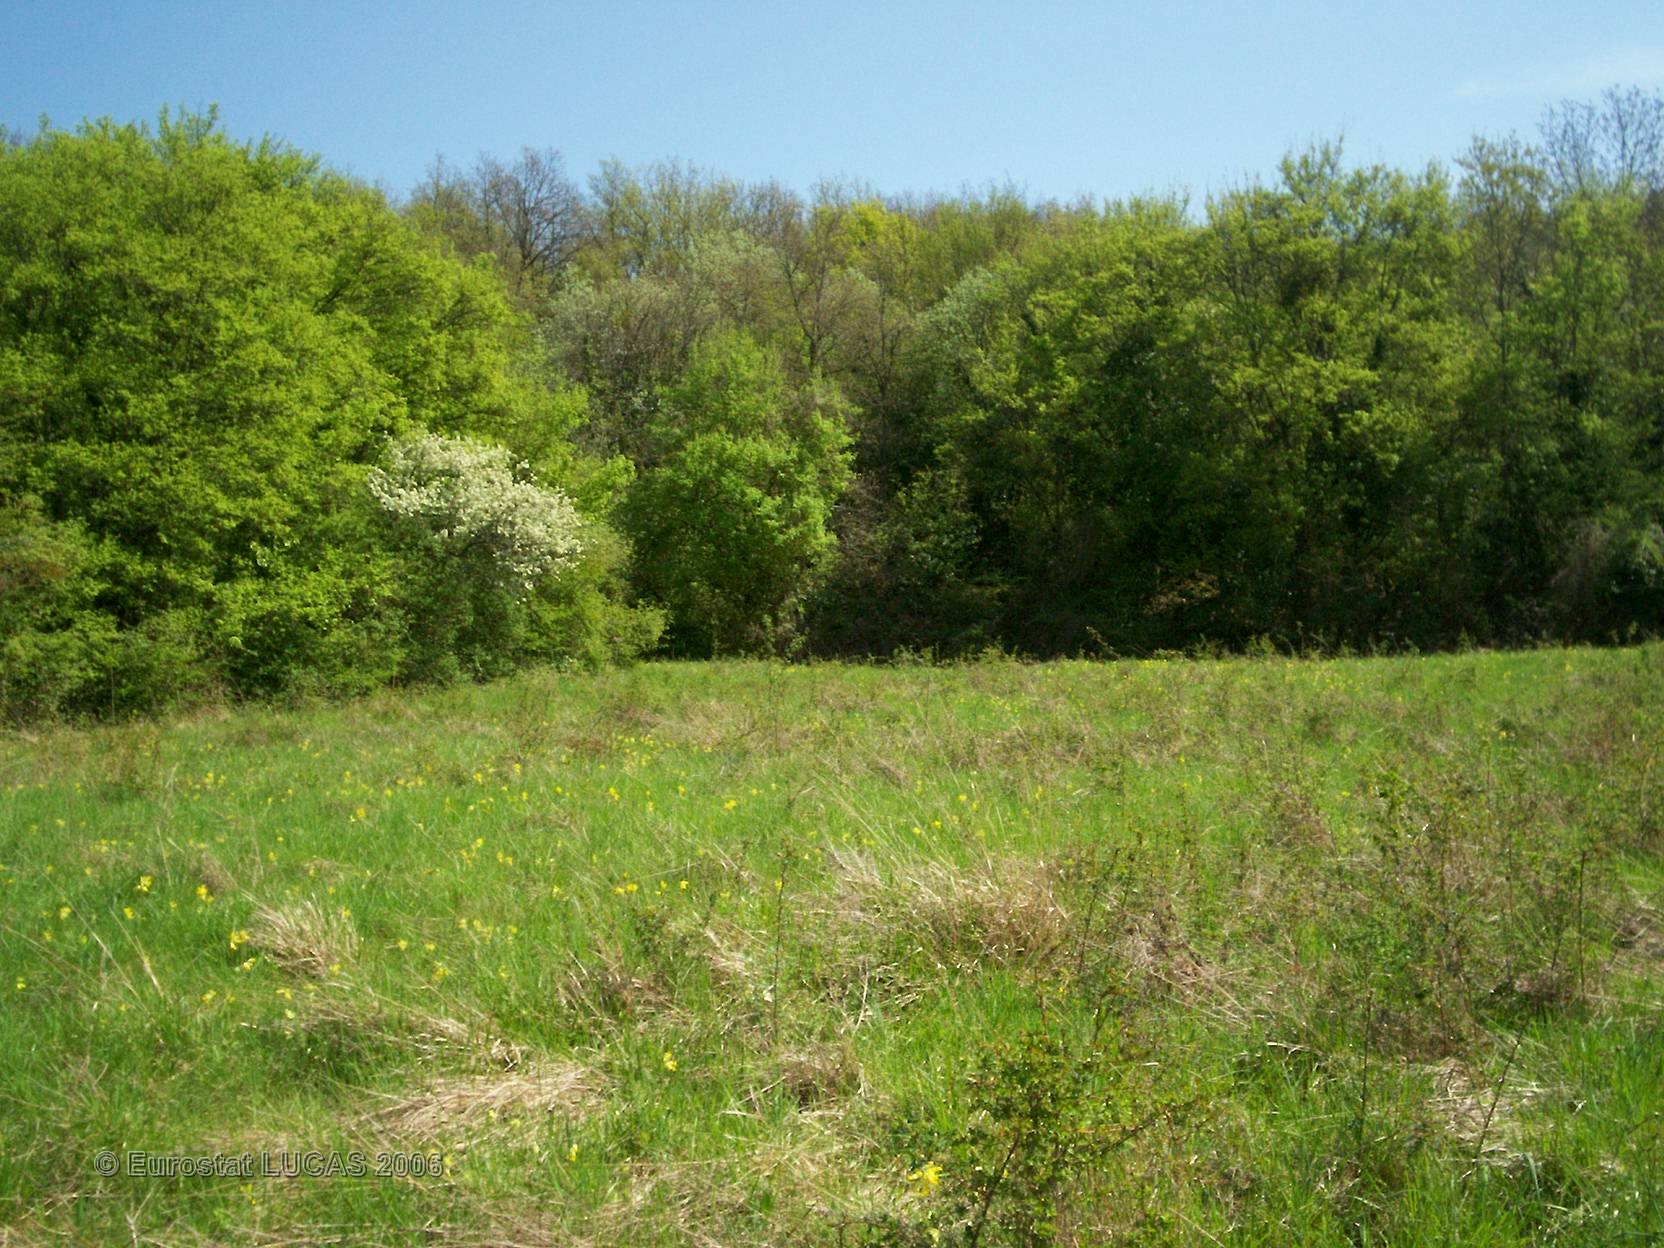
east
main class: Grassland
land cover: Grassland without tree/shrub cover
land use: Unused
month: April
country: FR
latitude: 46.8869
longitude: 4.6858
